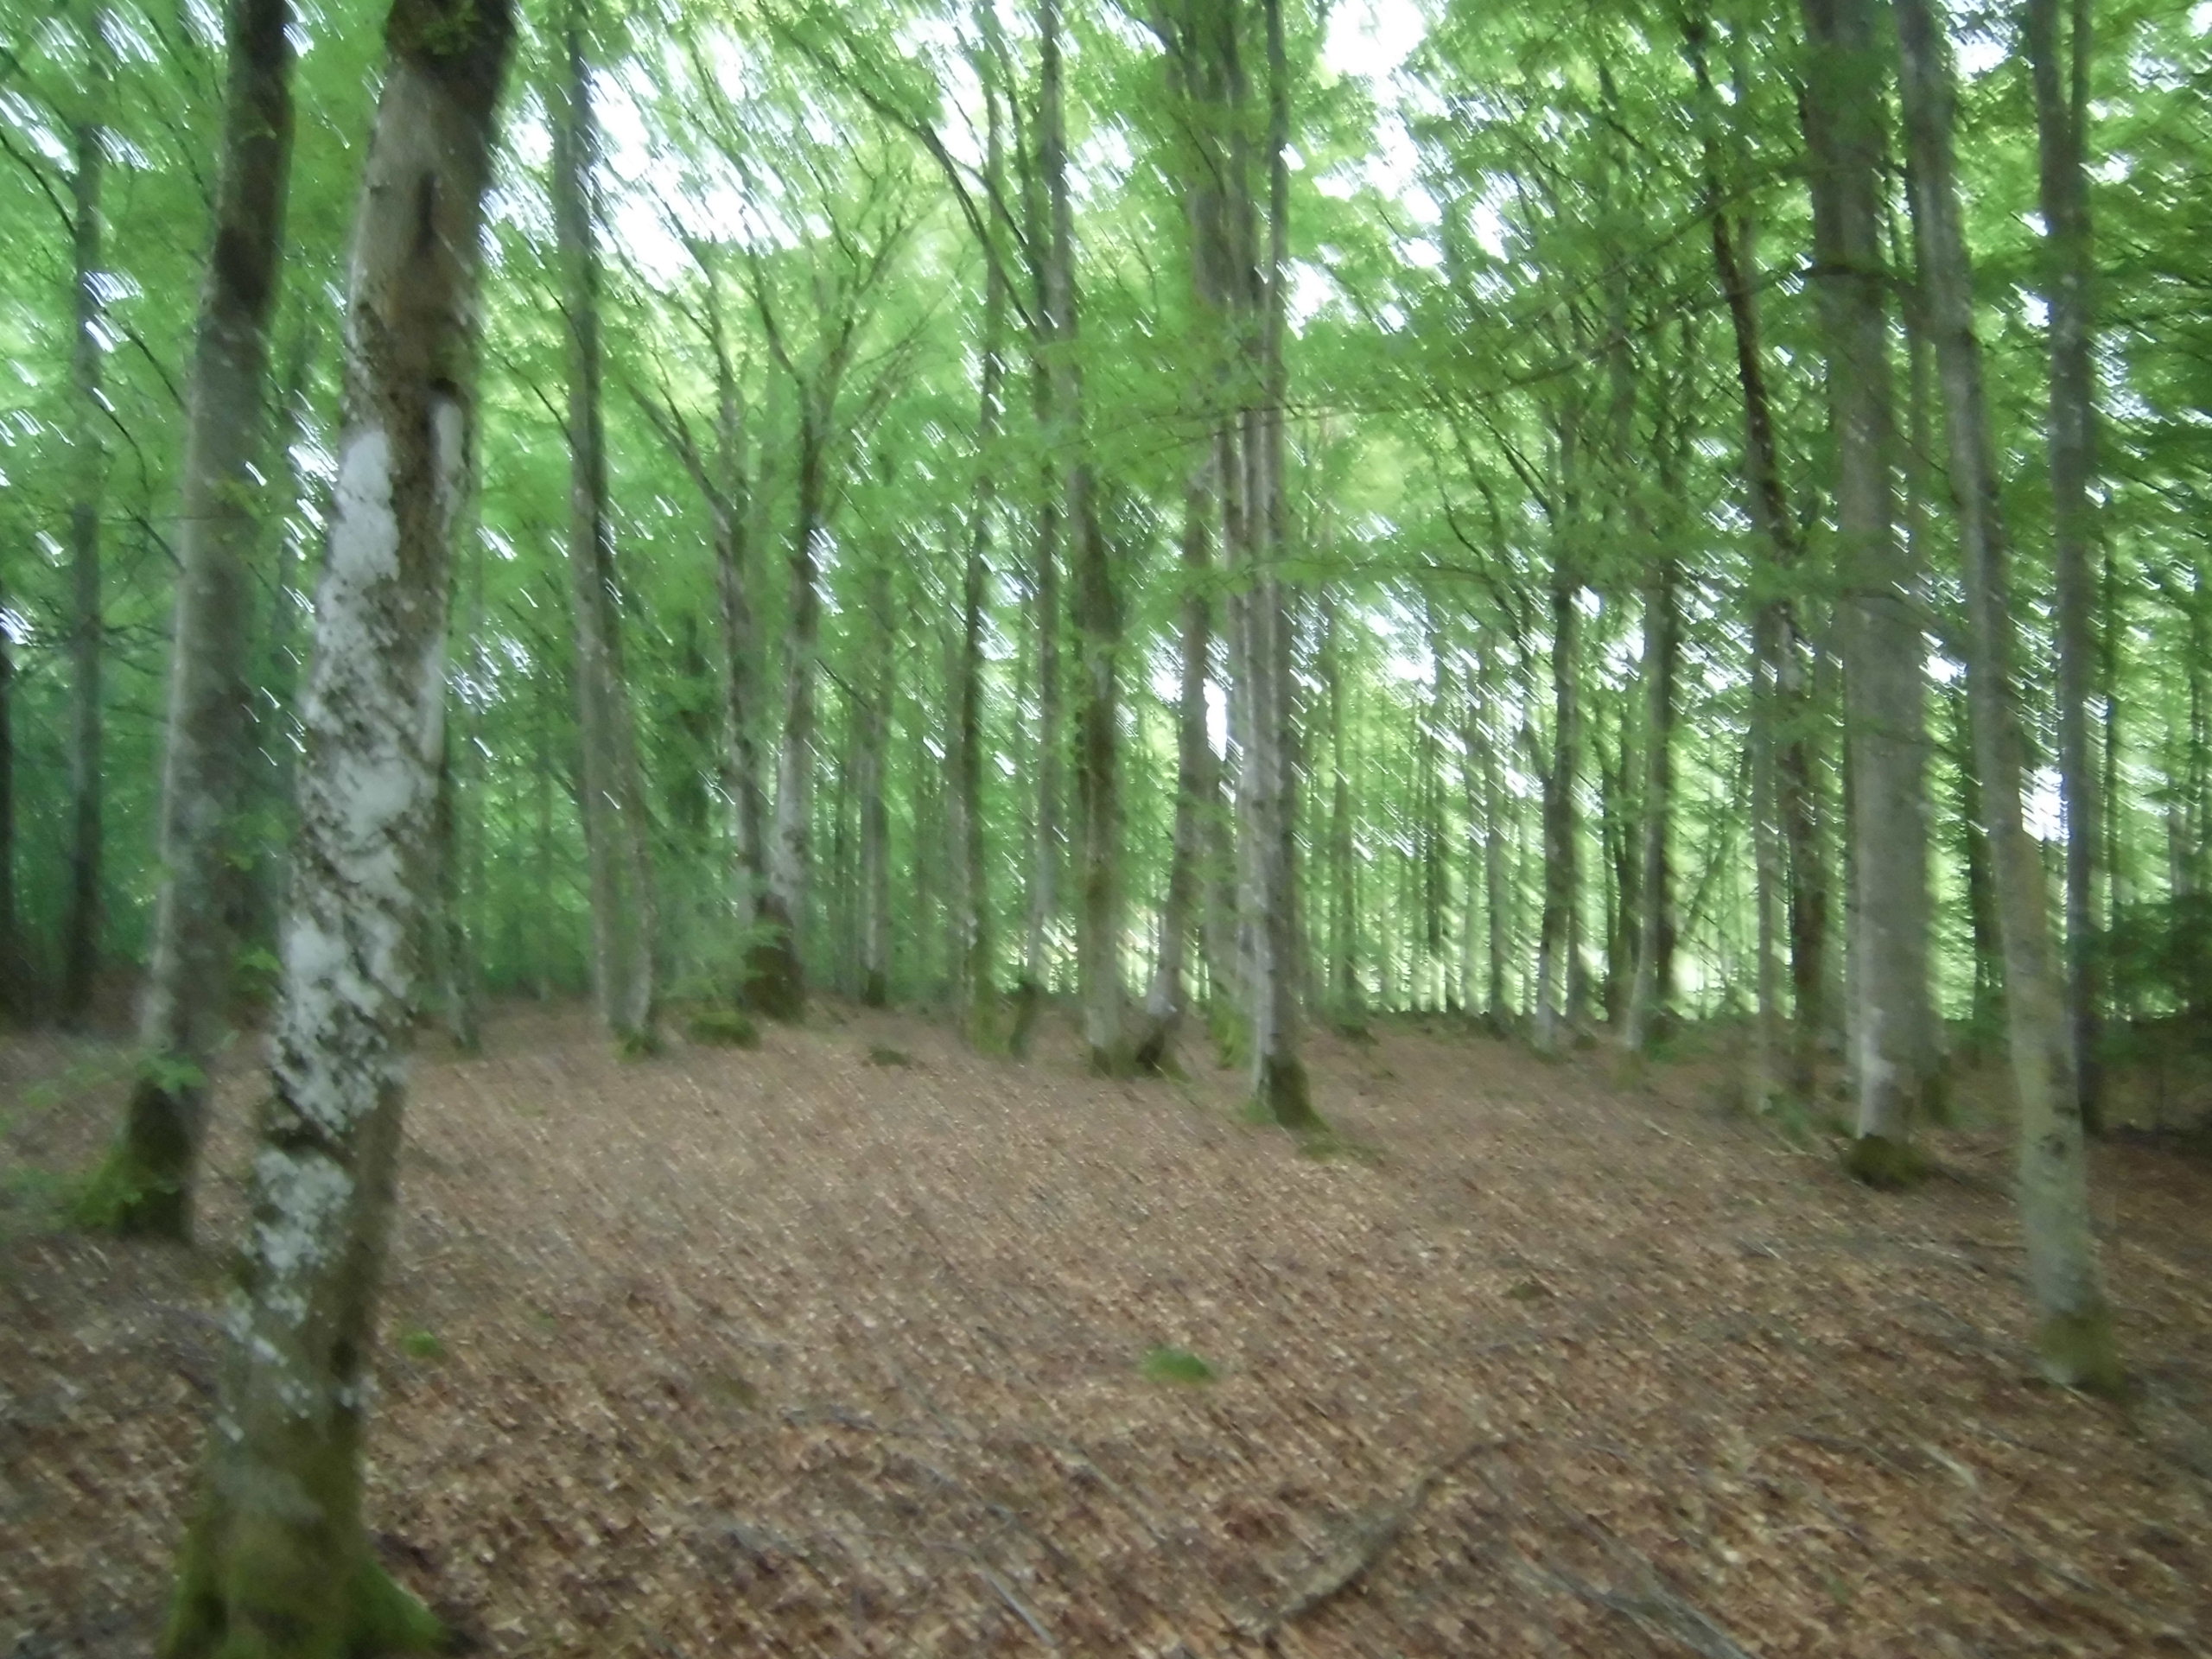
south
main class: Woodland
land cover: Broadleaved woodland
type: beech forest
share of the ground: 50 - 75 %
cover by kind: broadleaved forest trees 75 %, unconsolidated bare surface 15 %, herbaceous plants 5 %, lichens and mosses 5 %
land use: Forestry
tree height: > 5 m
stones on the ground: 25 - 50 %
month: June
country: SE
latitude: 57.0218
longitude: 14.6584
